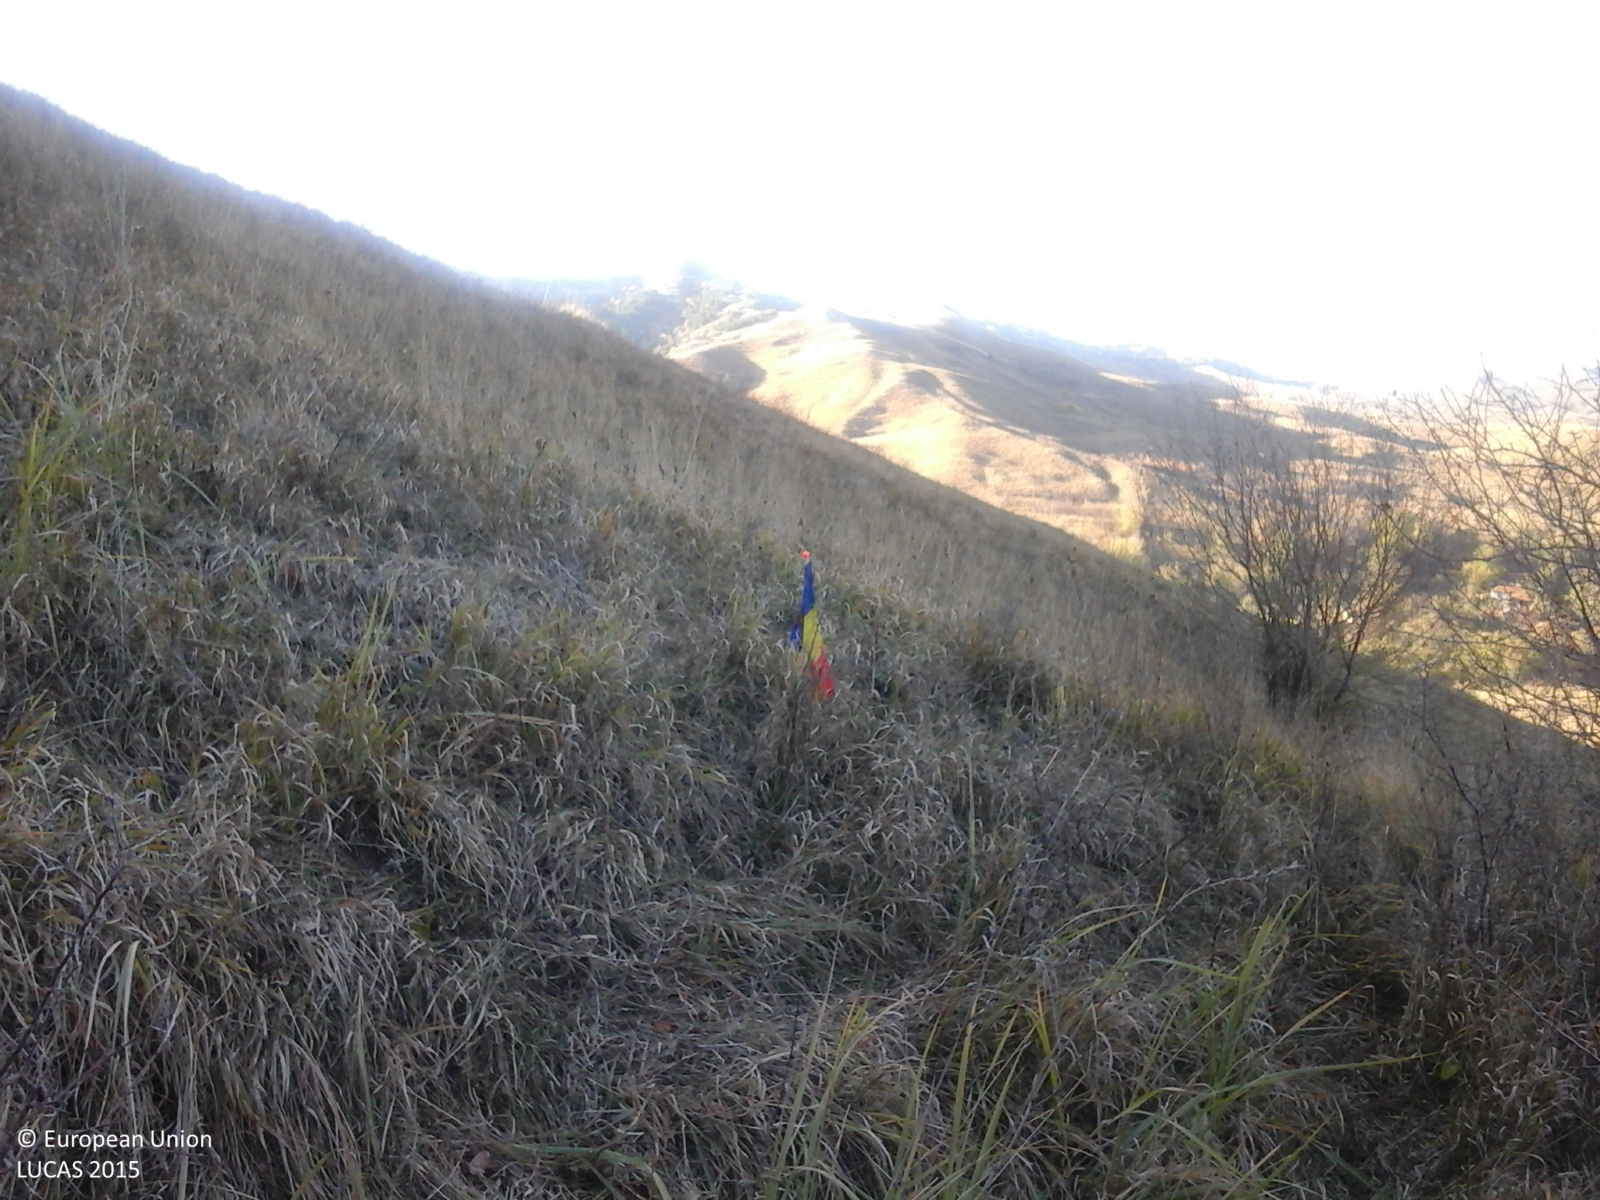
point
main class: Grassland
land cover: Grassland with sparse tree/shrub cover
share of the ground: > 75 %
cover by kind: herbaceous plants 85 %, shrubs 10 %, broadleaved forest trees 5 %
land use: Agriculture (excluding fallow land and kitchen gardens)
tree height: > 5 m
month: October
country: RO
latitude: 45.3203
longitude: 26.7007
